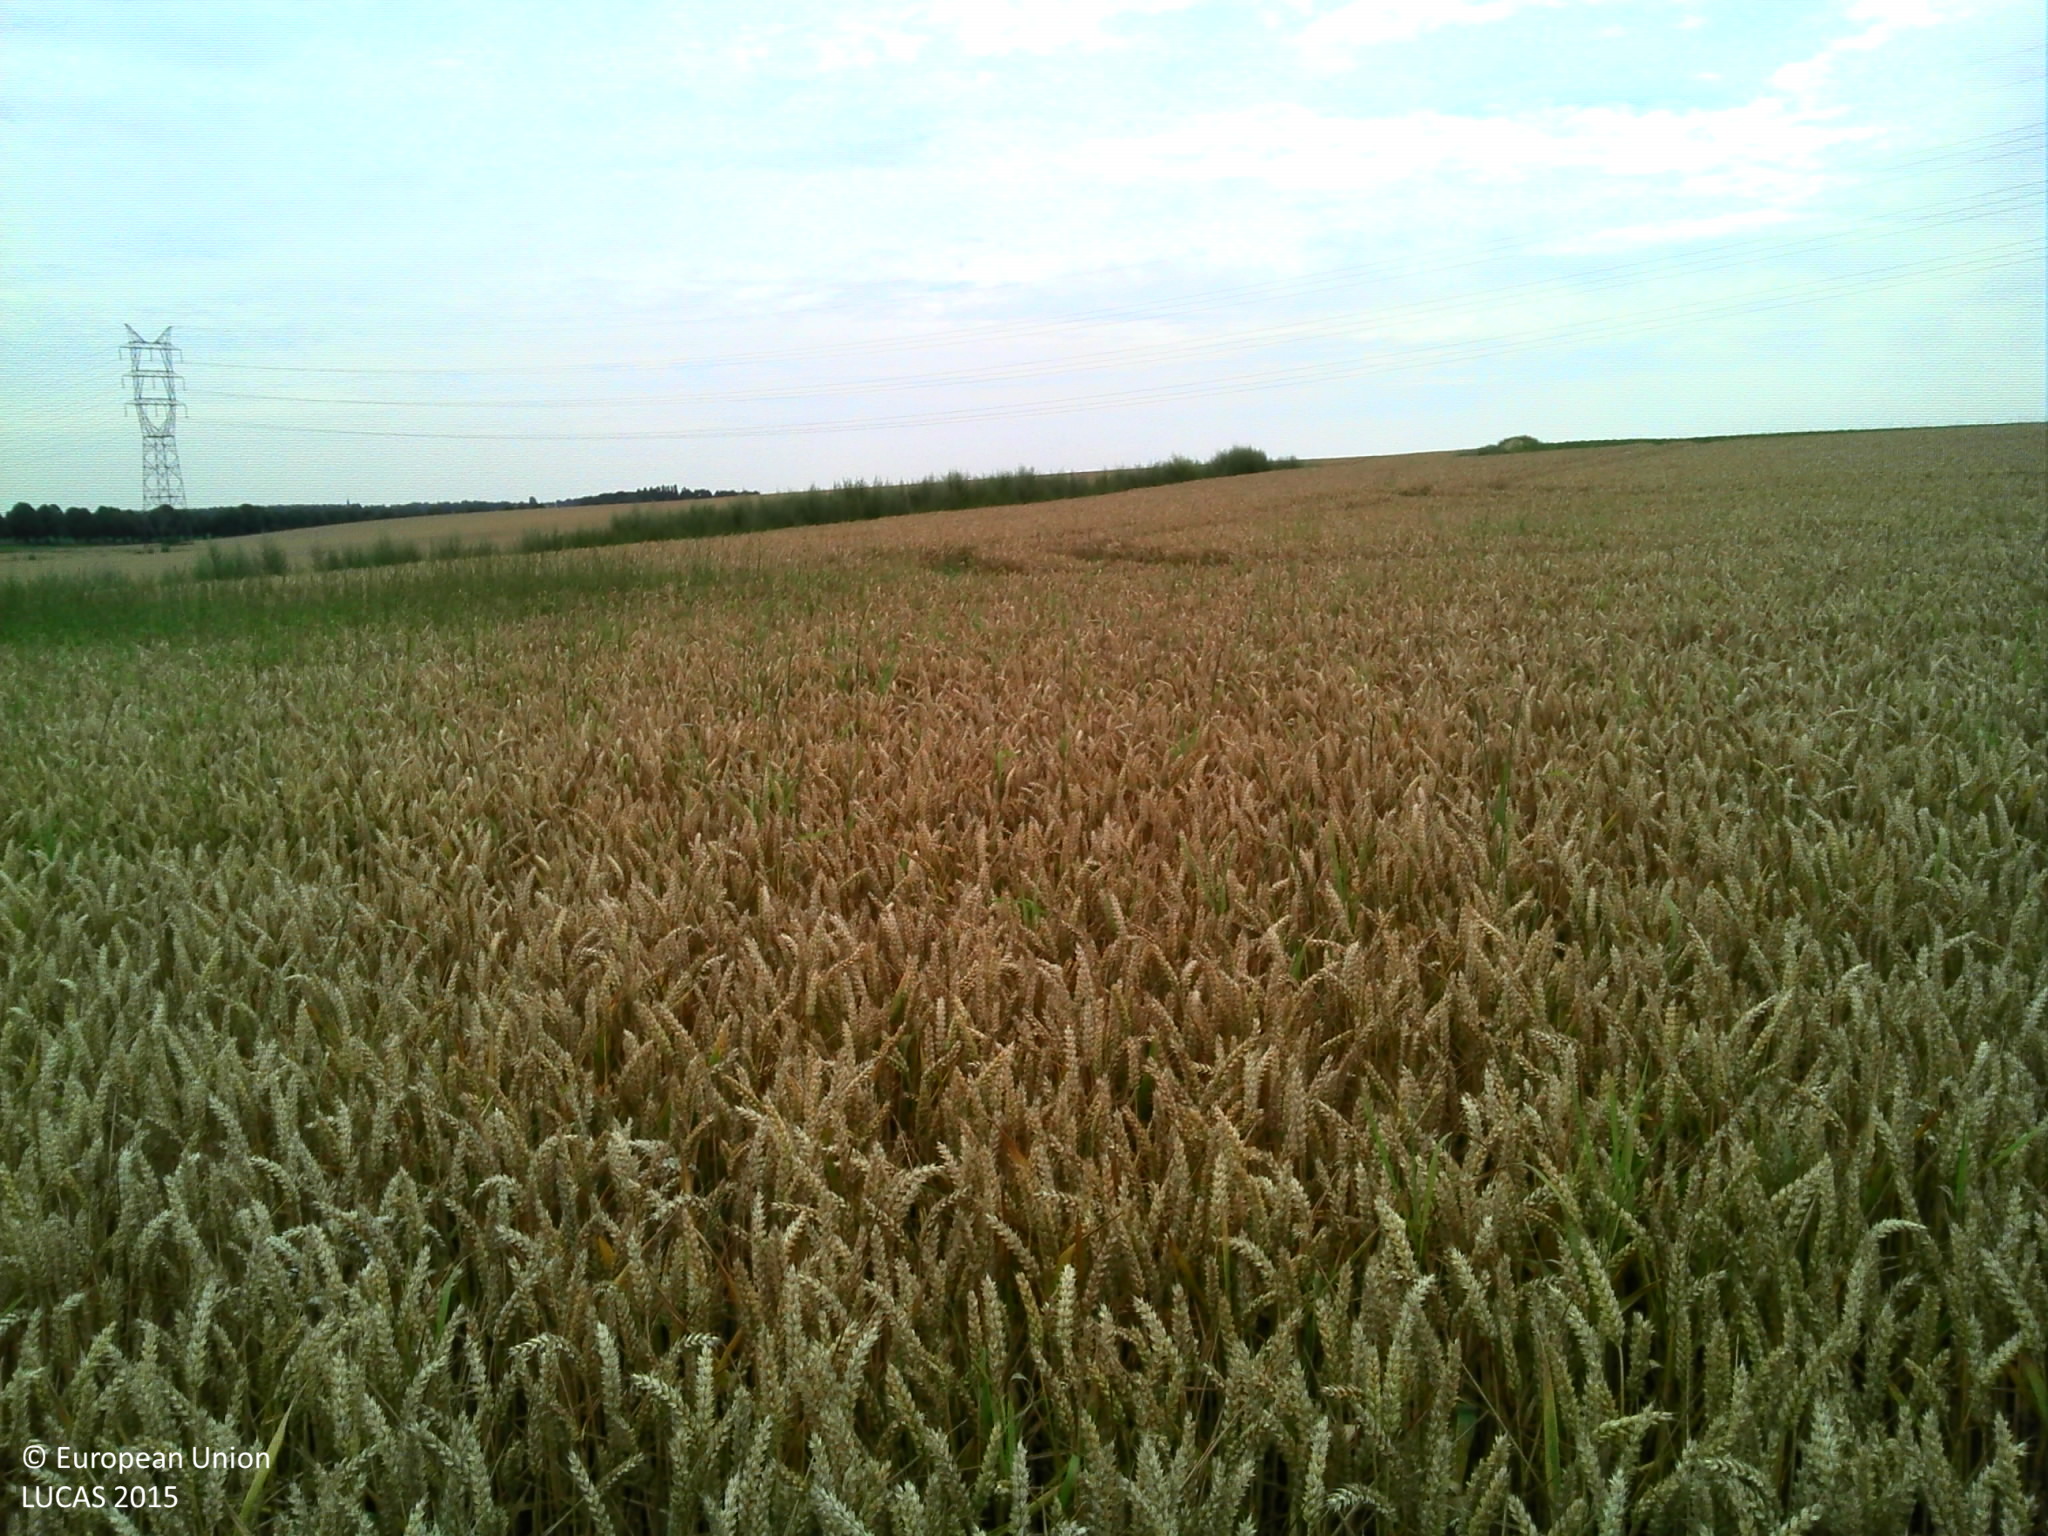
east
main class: Cropland
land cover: Common wheat
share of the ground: > 75 %
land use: Agriculture (excluding fallow land and kitchen gardens)
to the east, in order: Common wheat; Grass margins; Common wheat
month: July
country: BE
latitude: 50.5303
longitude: 4.3383
